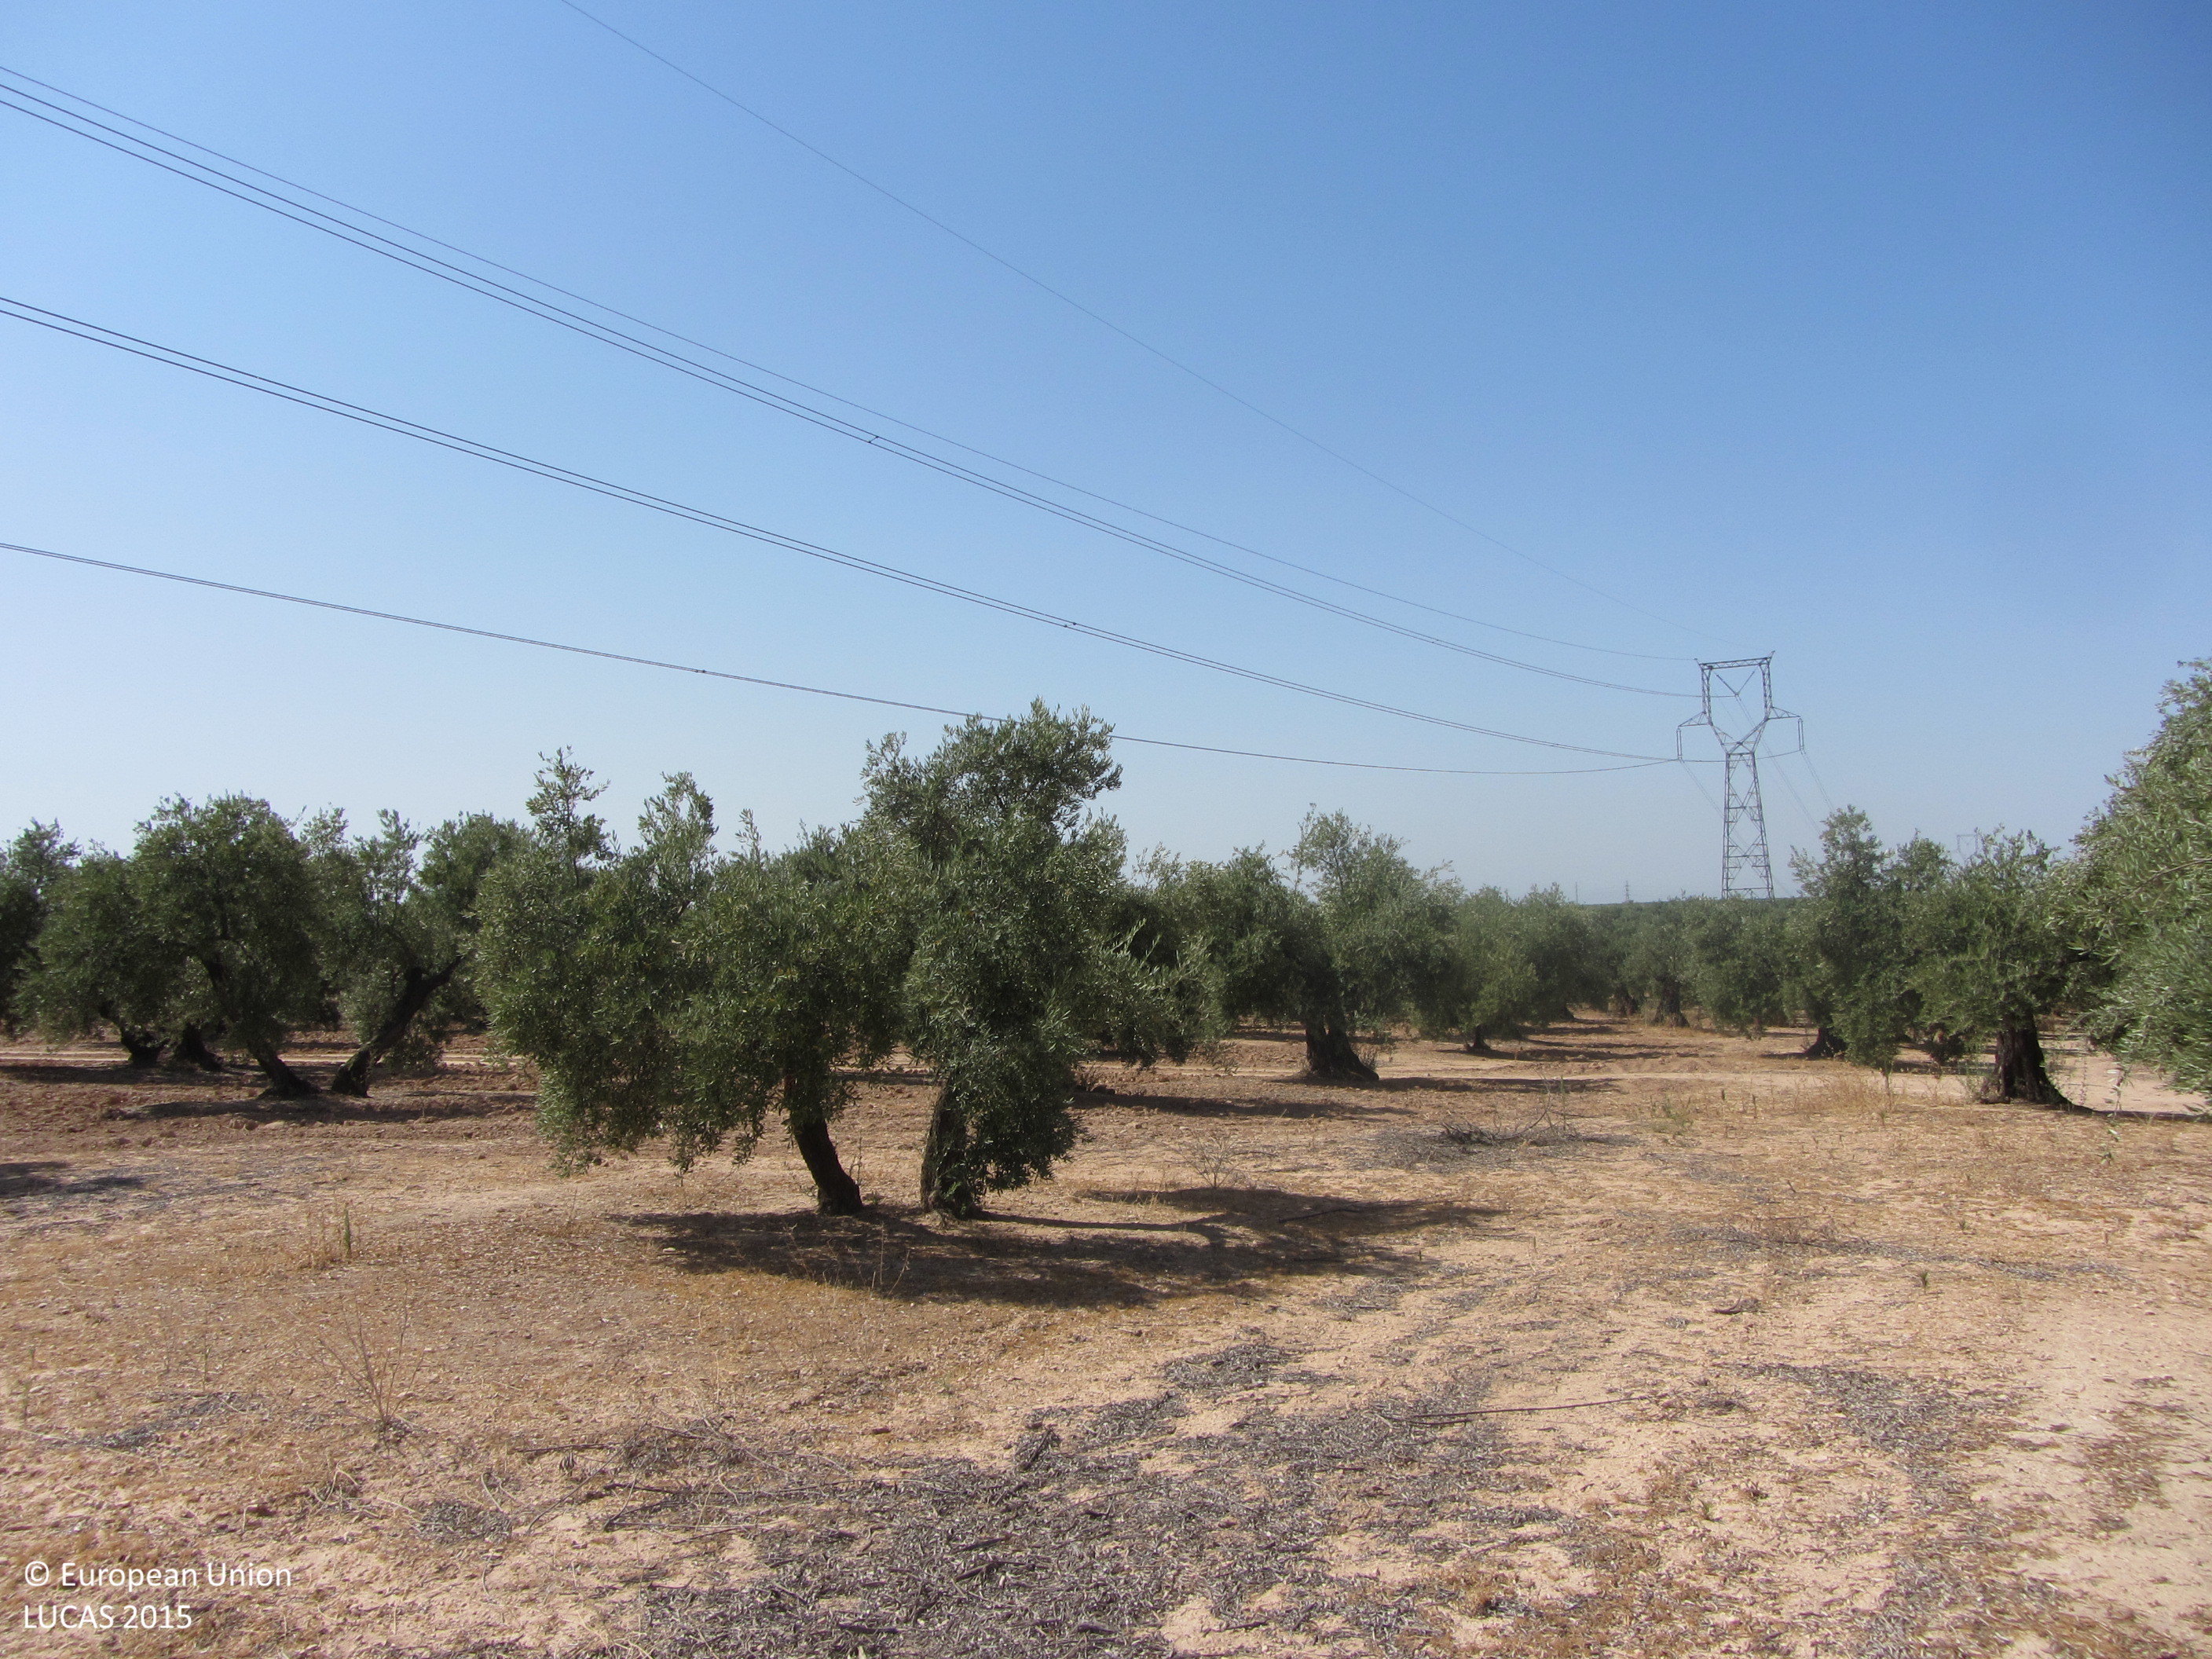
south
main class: Cropland
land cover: Olive groves
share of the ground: 25 - 50 %
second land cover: Other bare soil
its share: > 75 %
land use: Agriculture (excluding fallow land and kitchen gardens)
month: July
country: ES
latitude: 37.9976
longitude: -4.2093
